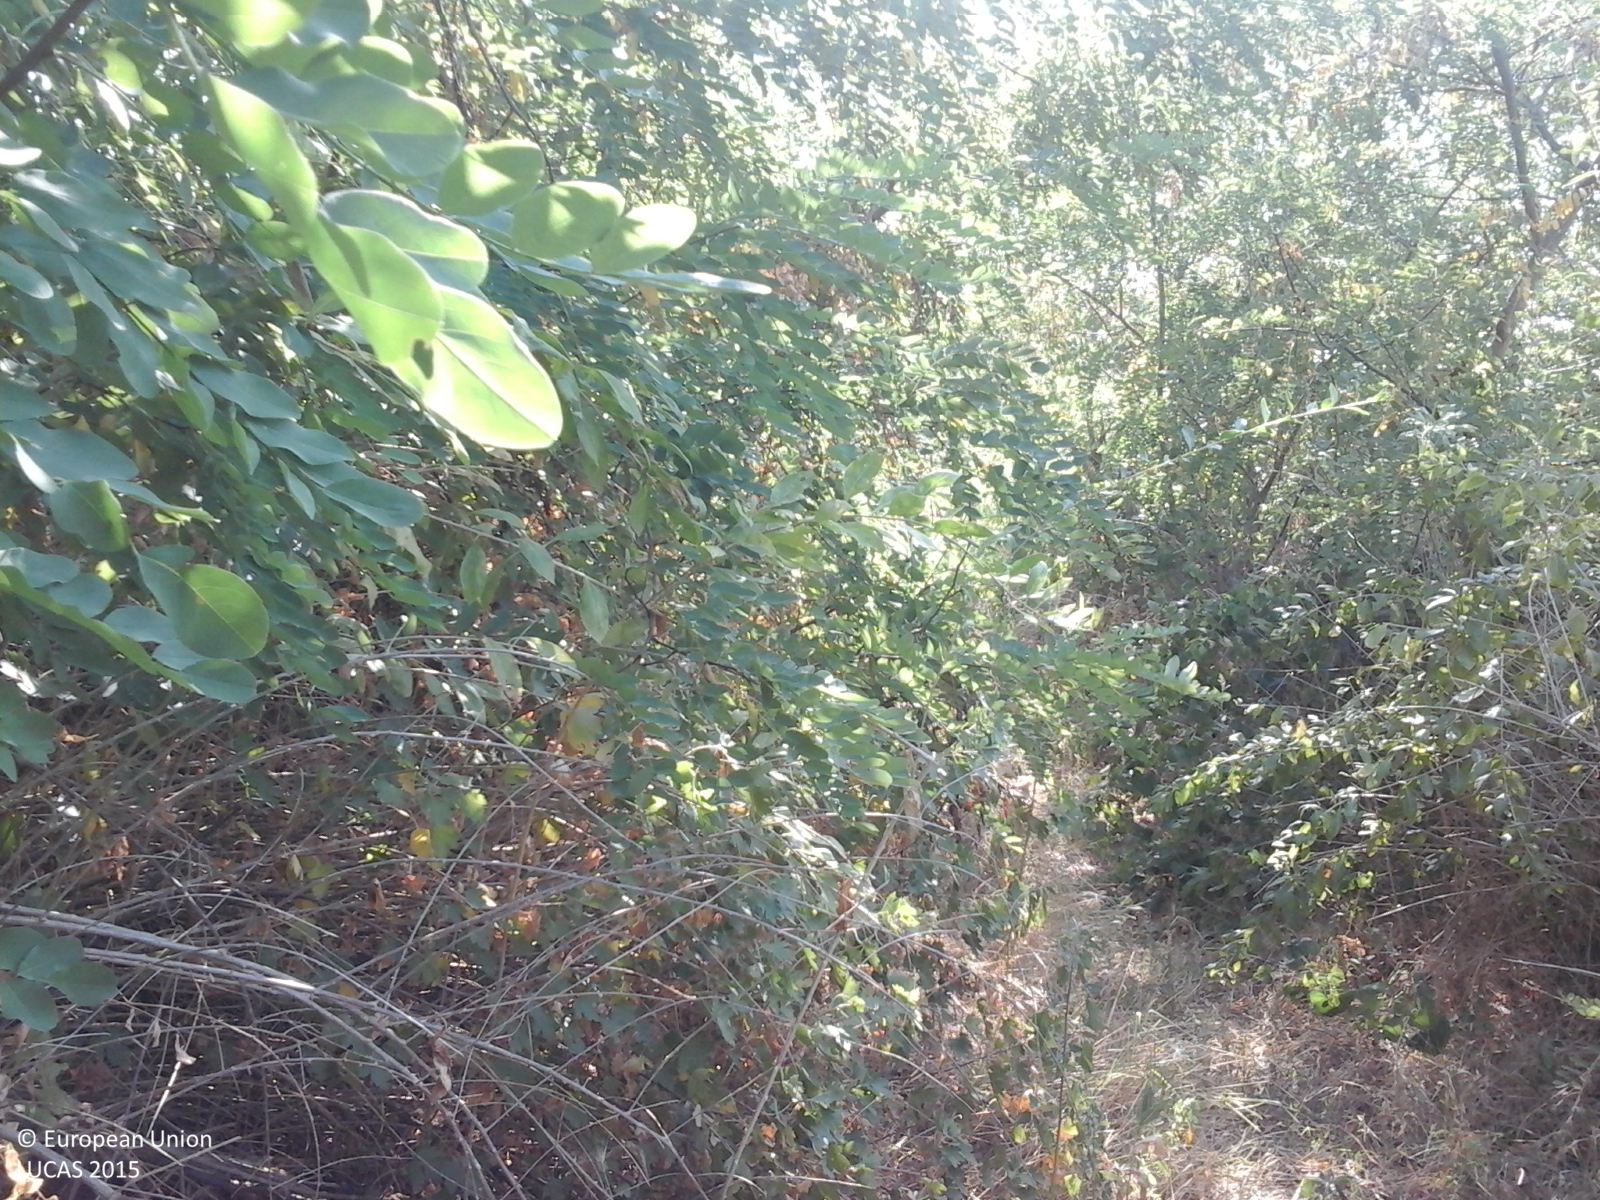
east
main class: Shrubland
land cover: Shrubland with sparse tree cover
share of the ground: > 75 %
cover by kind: shrubs 95 %, broadleaved forest trees 5 %
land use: Semi-natural and natural areas not in use
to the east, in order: Shrubland with sparse tree cover; Grassland without tree/shrub cover; Abandoned hedges; Vineyards; Lines of trees; Paved roads, cycling and walking lanes; Vineyards; Abandoned hedges; Vineyards; Shruby margins; Vineyards
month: August
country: RO
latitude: 44.0650
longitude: 23.0896
